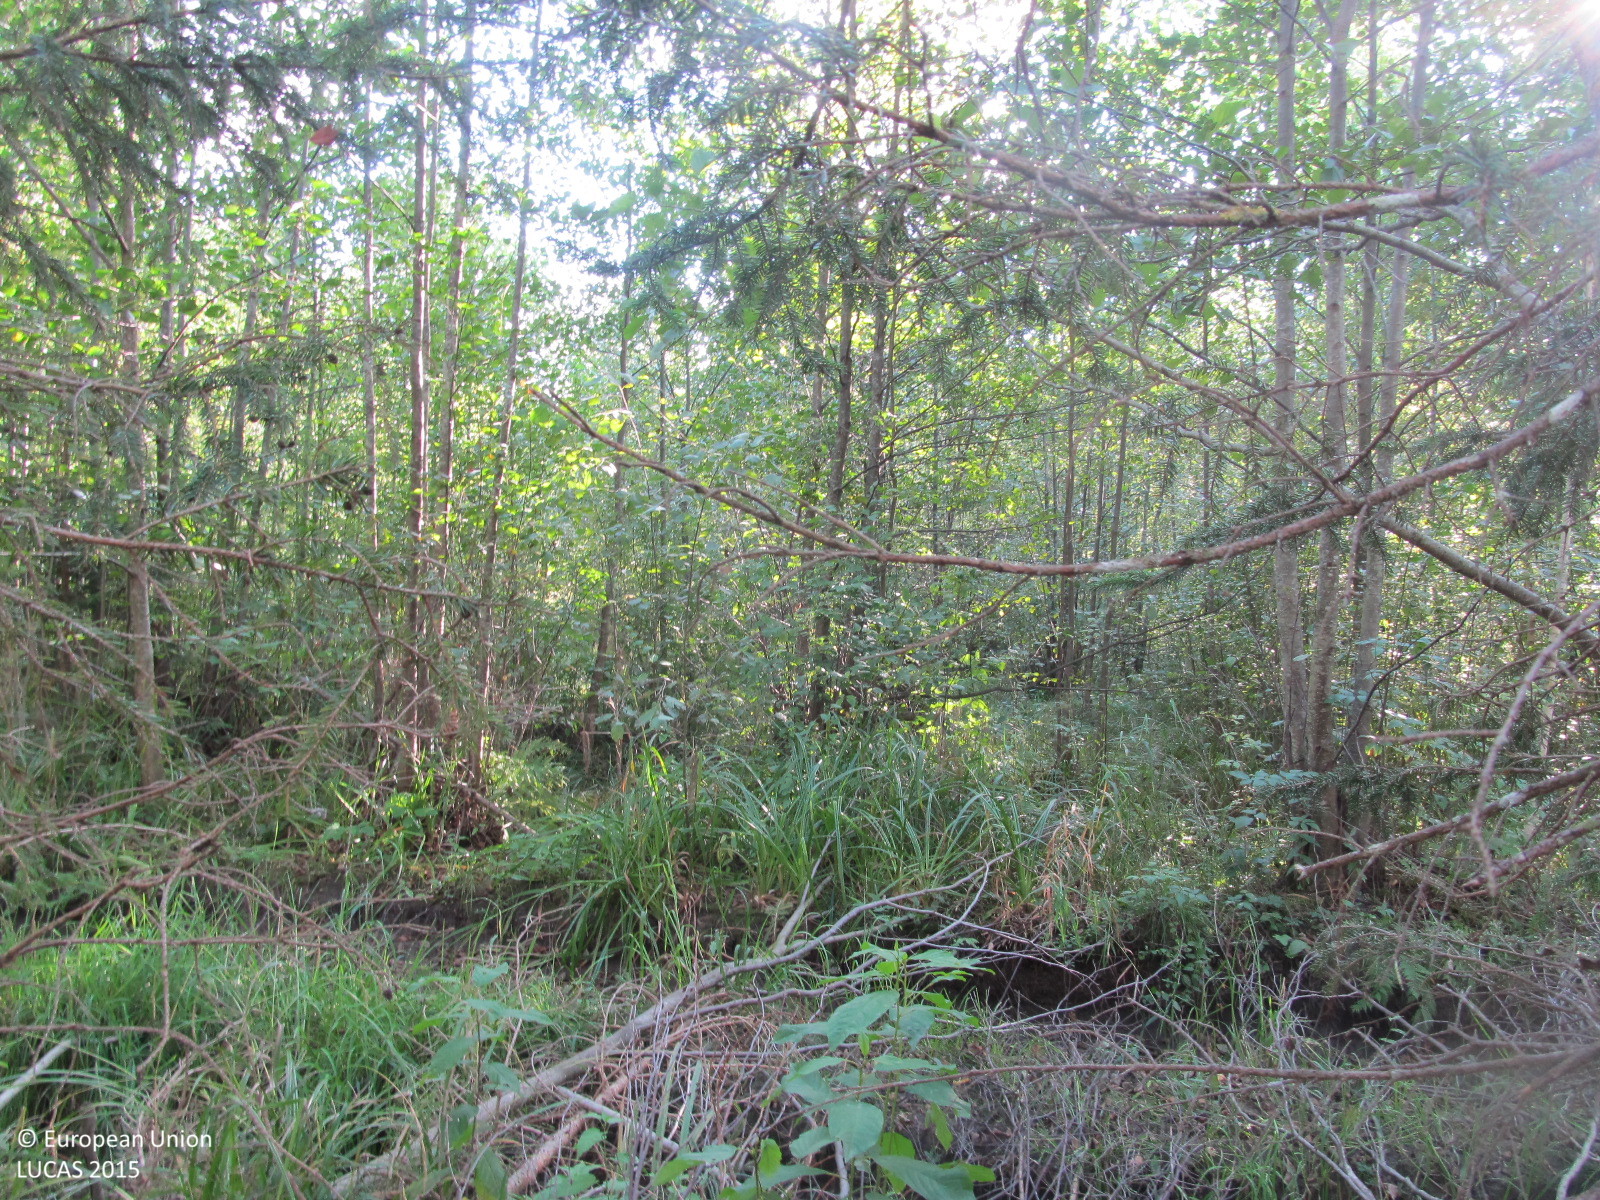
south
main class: Woodland
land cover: Broadleaved woodland
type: non-riverine alder, birch or aspen forest
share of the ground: 50 - 75 %
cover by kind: broadleaved forest trees 60 %, herbaceous plants 20 %, coniferous forest trees 10 %, lichens and mosses 5 %, unconsolidated bare surface 5 %
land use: Forestry
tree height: > 5 m
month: September
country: LT
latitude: 56.1221
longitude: 23.3771
